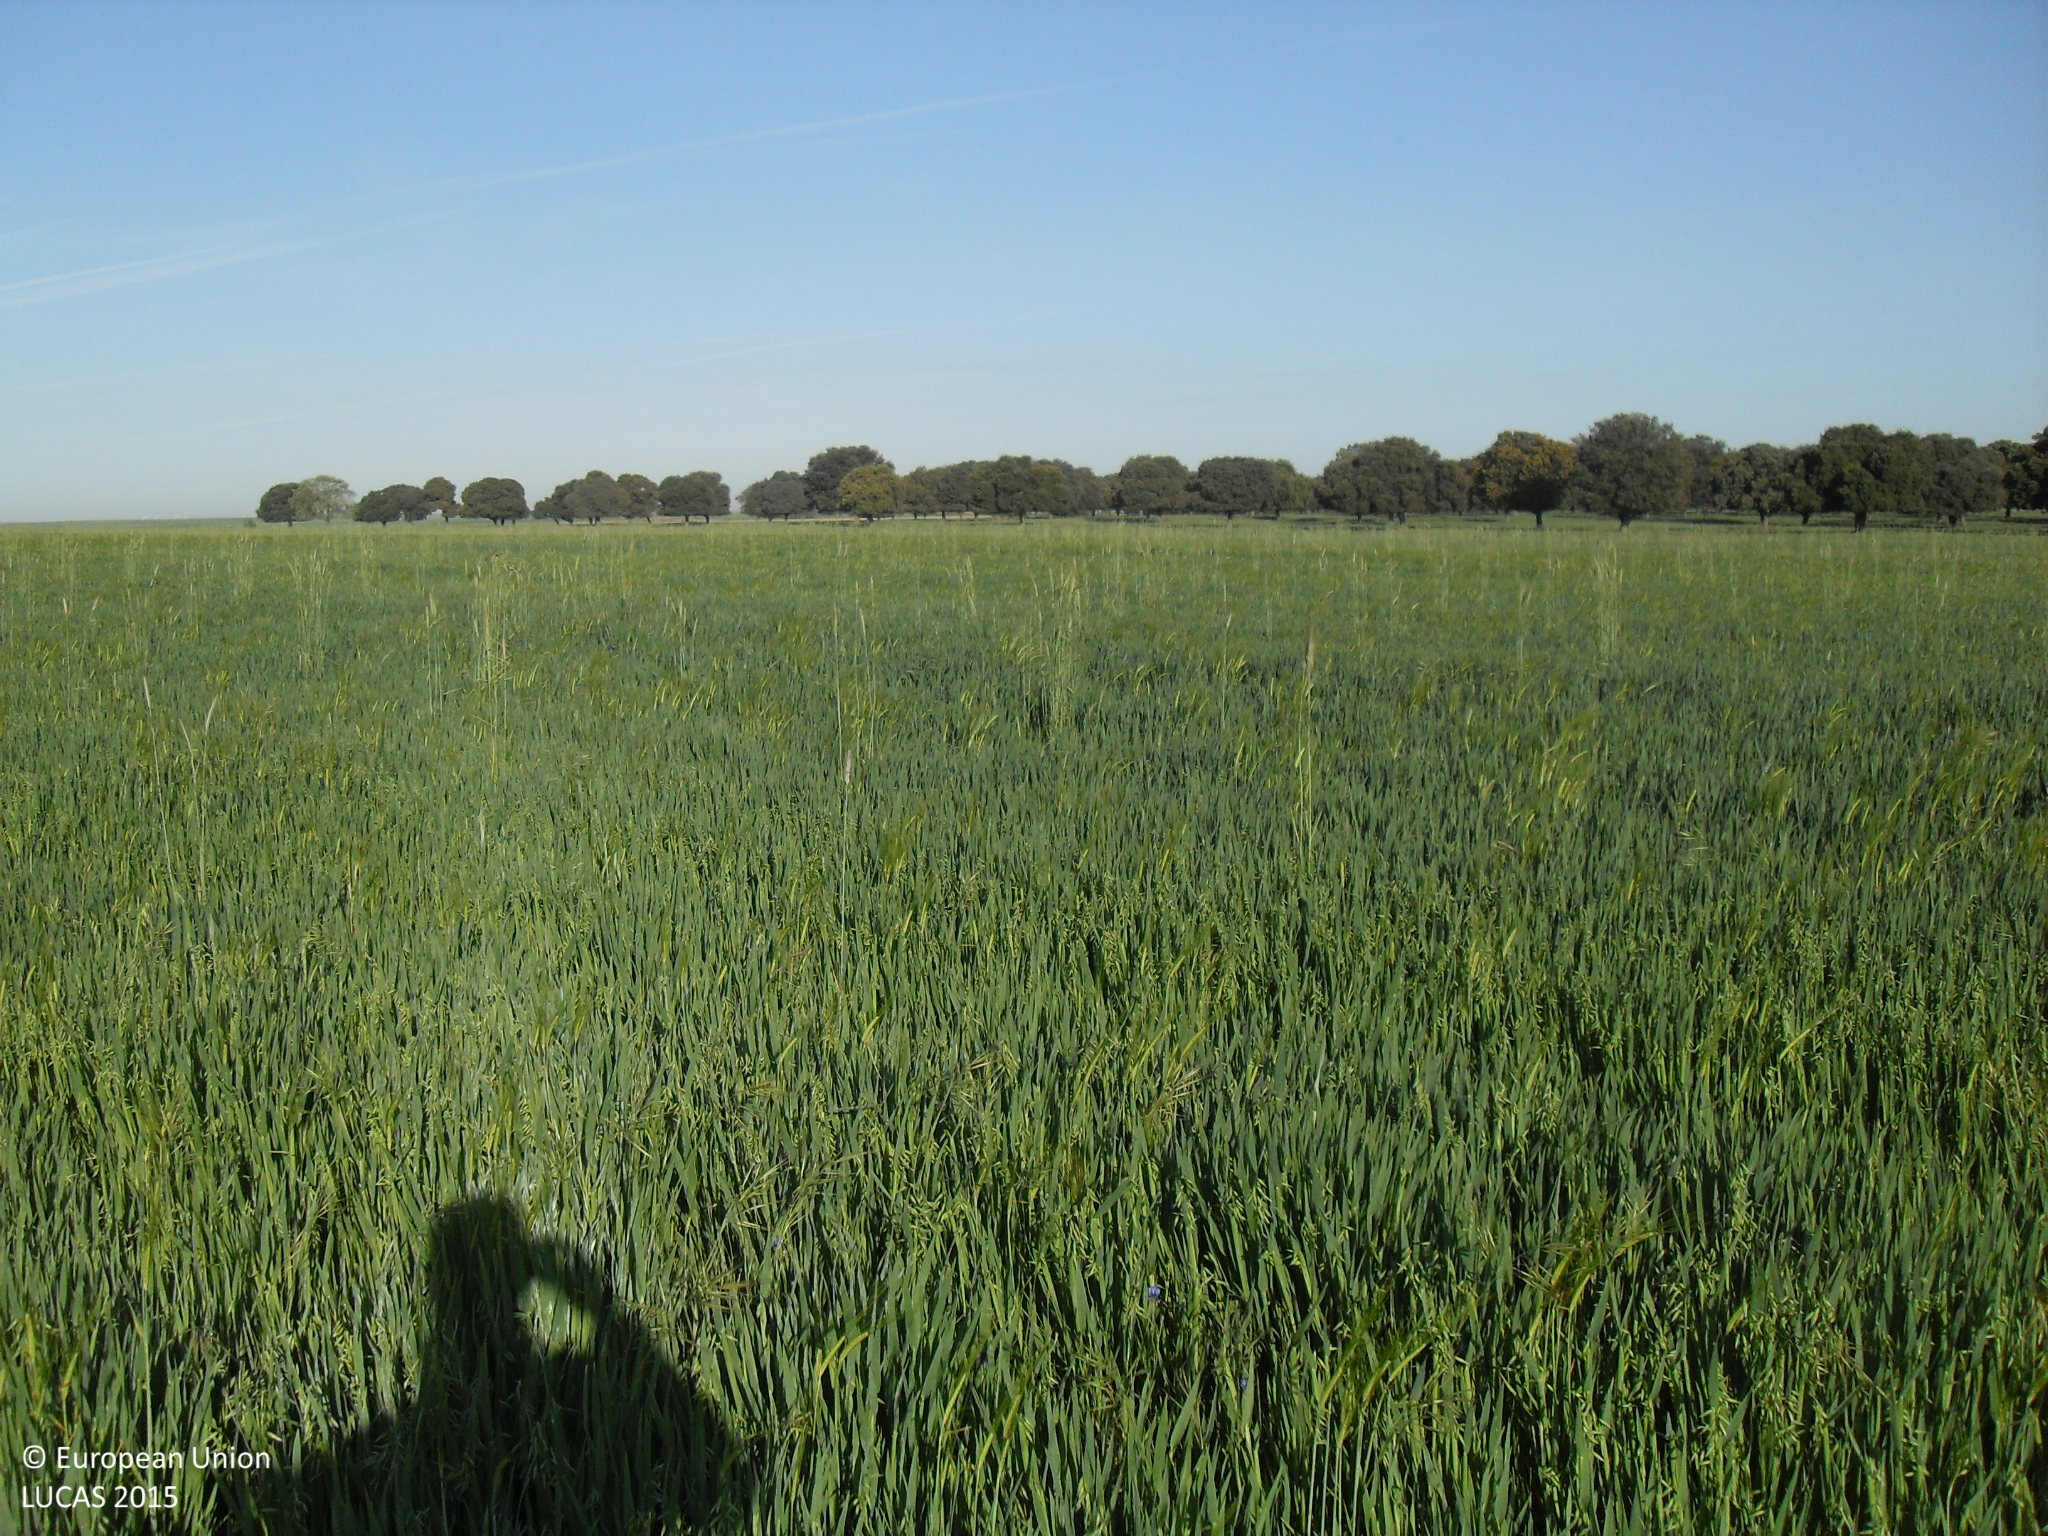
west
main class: Cropland
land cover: Oats
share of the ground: > 75 %
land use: Agriculture (excluding fallow land and kitchen gardens)
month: May
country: ES
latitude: 40.9002
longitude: -5.2752
